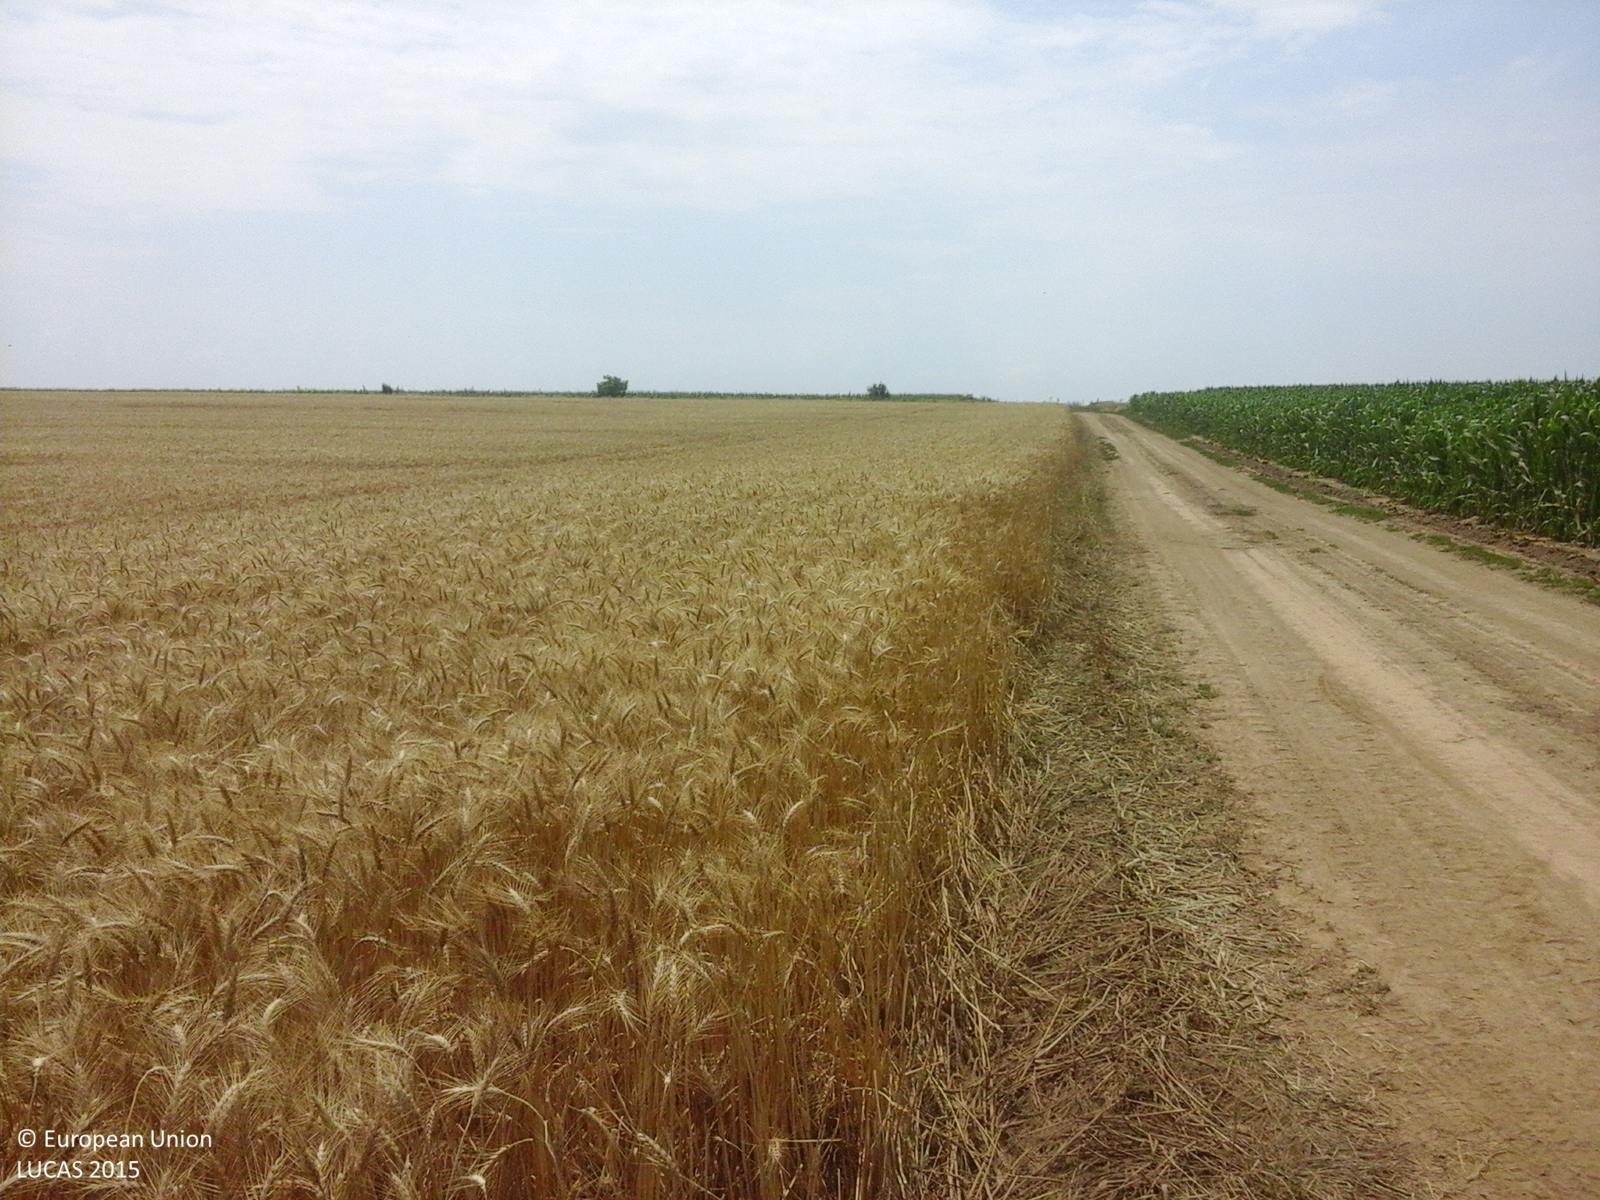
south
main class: Cropland
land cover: Common wheat
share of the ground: > 75 %
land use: Agriculture (excluding fallow land and kitchen gardens)
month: July
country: RO
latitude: 44.1788
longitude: 26.4855
